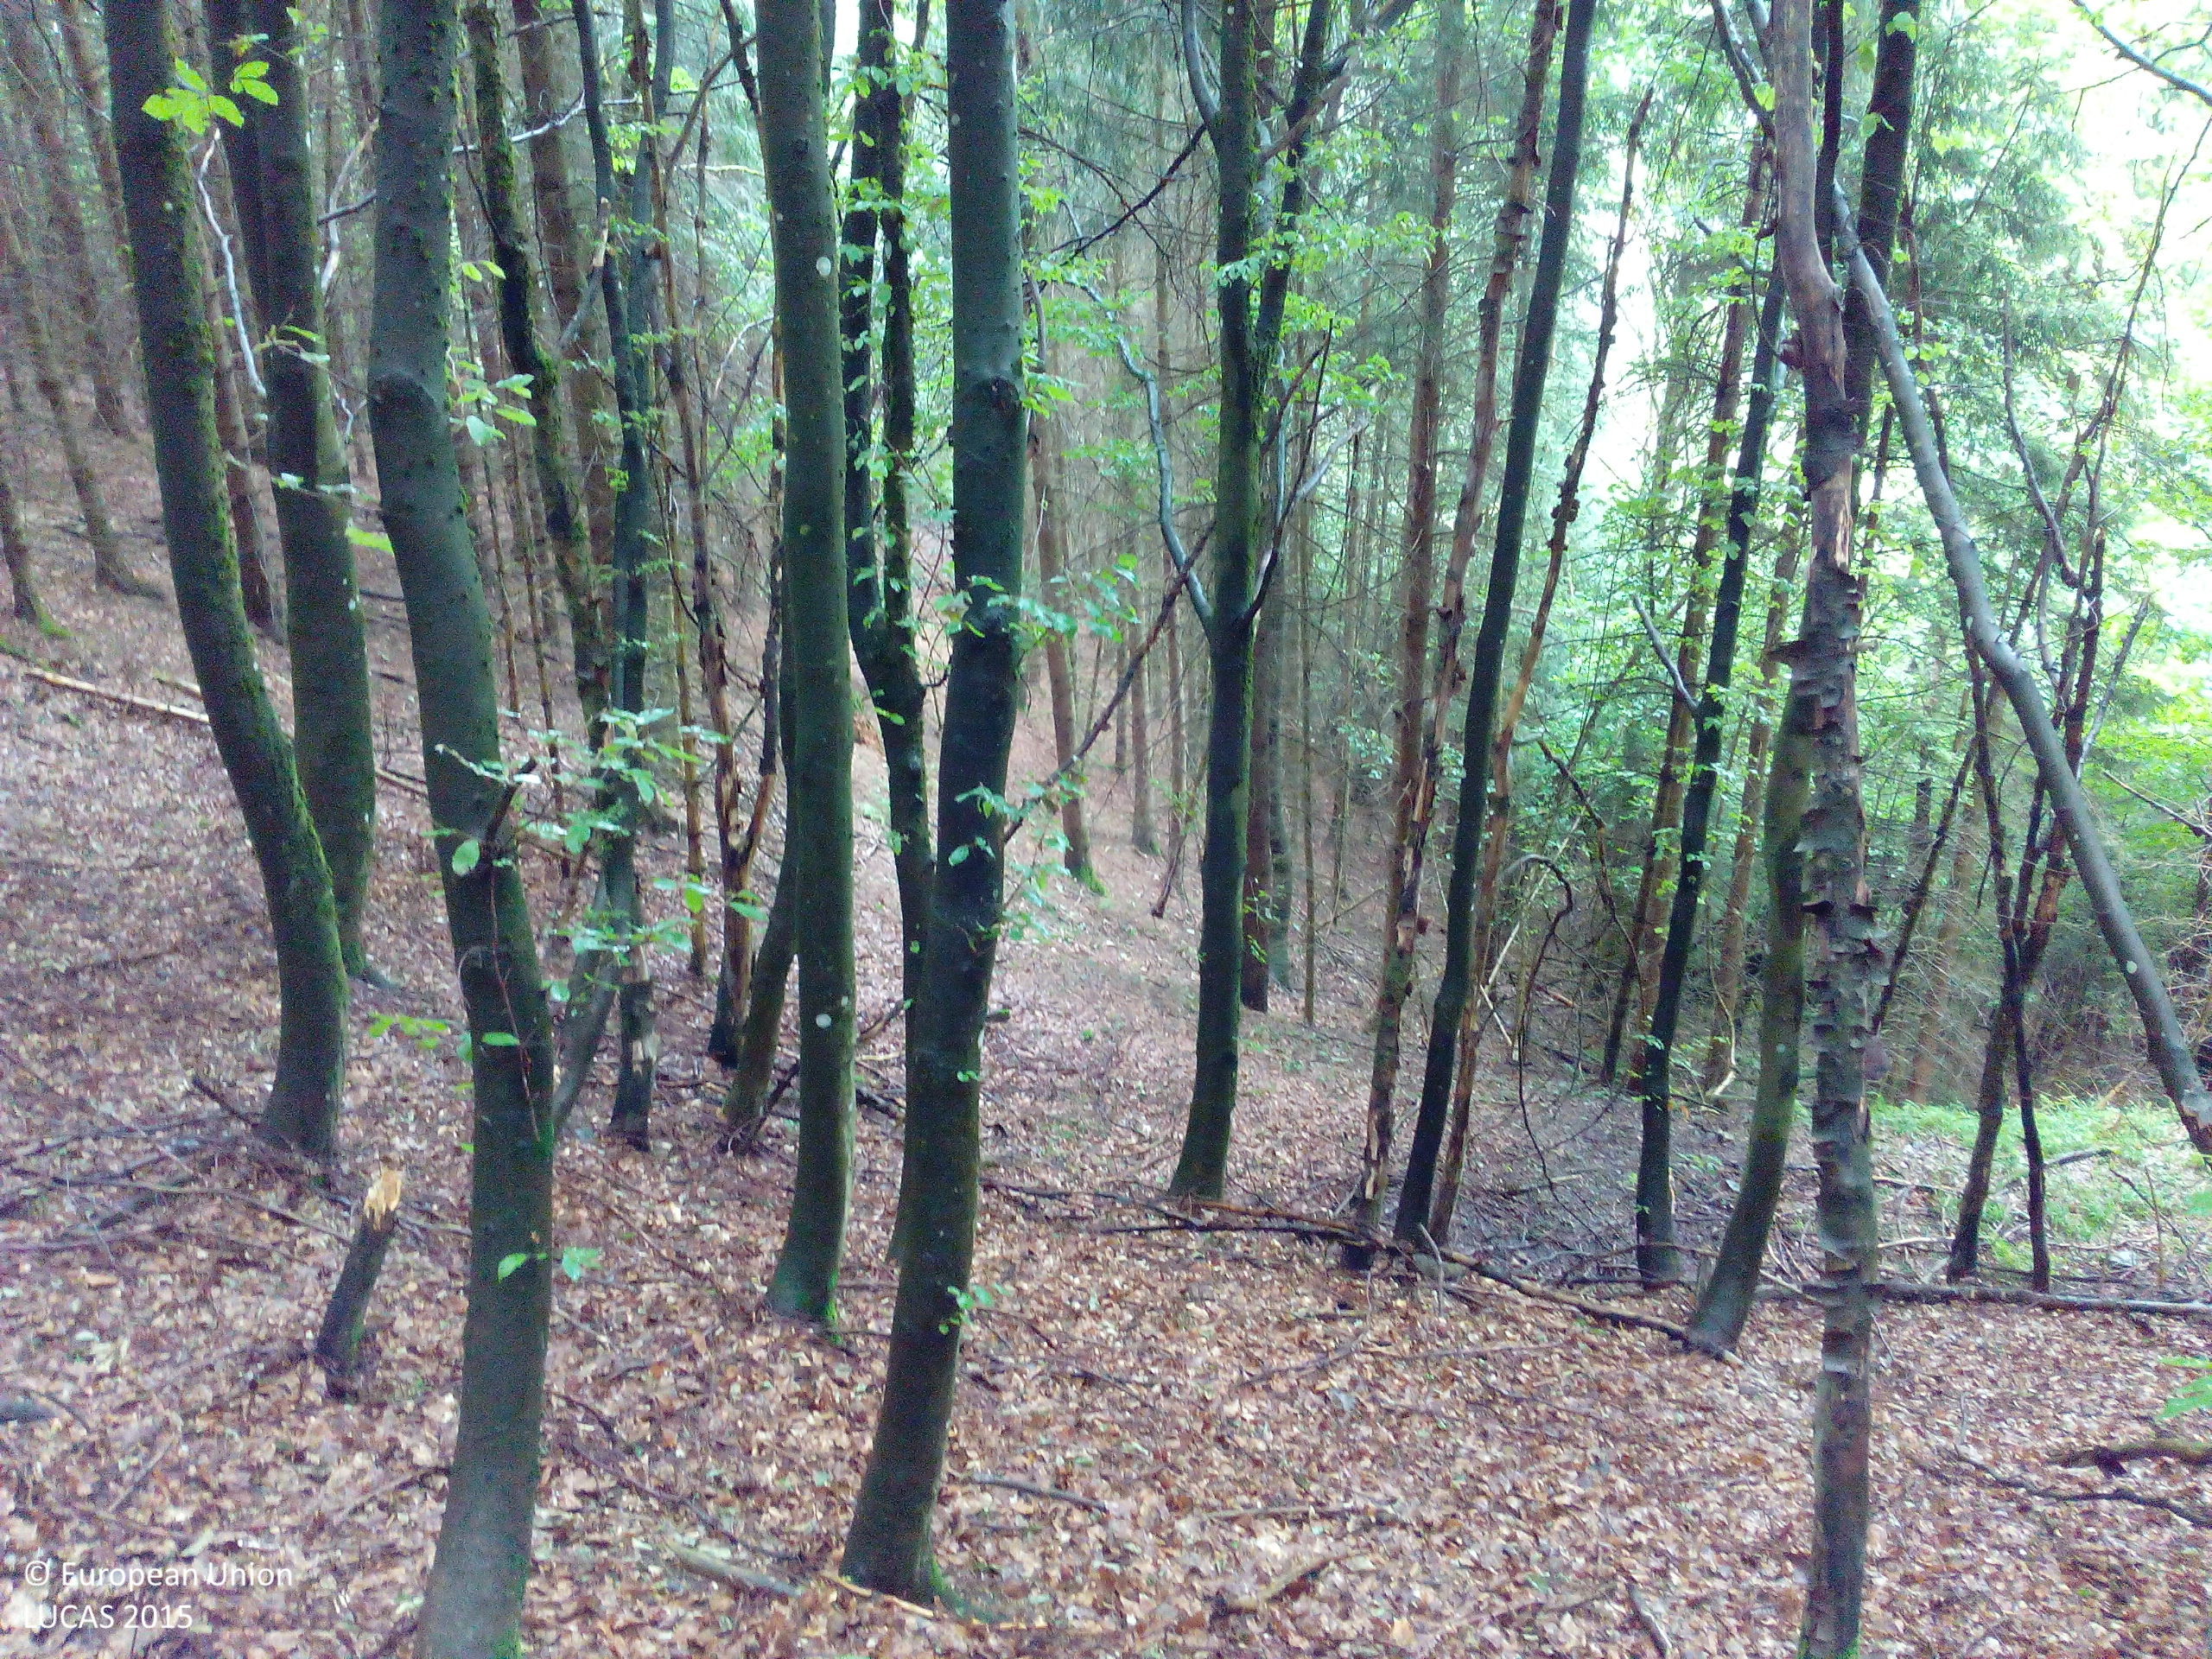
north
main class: Woodland
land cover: Broadleaved woodland
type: beech forest
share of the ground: > 75 %
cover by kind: broadleaved forest trees 90 %, unconsolidated bare surface 10 %
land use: Forestry
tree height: > 5 m
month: July
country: DE
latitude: 48.1713
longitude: 8.1050
